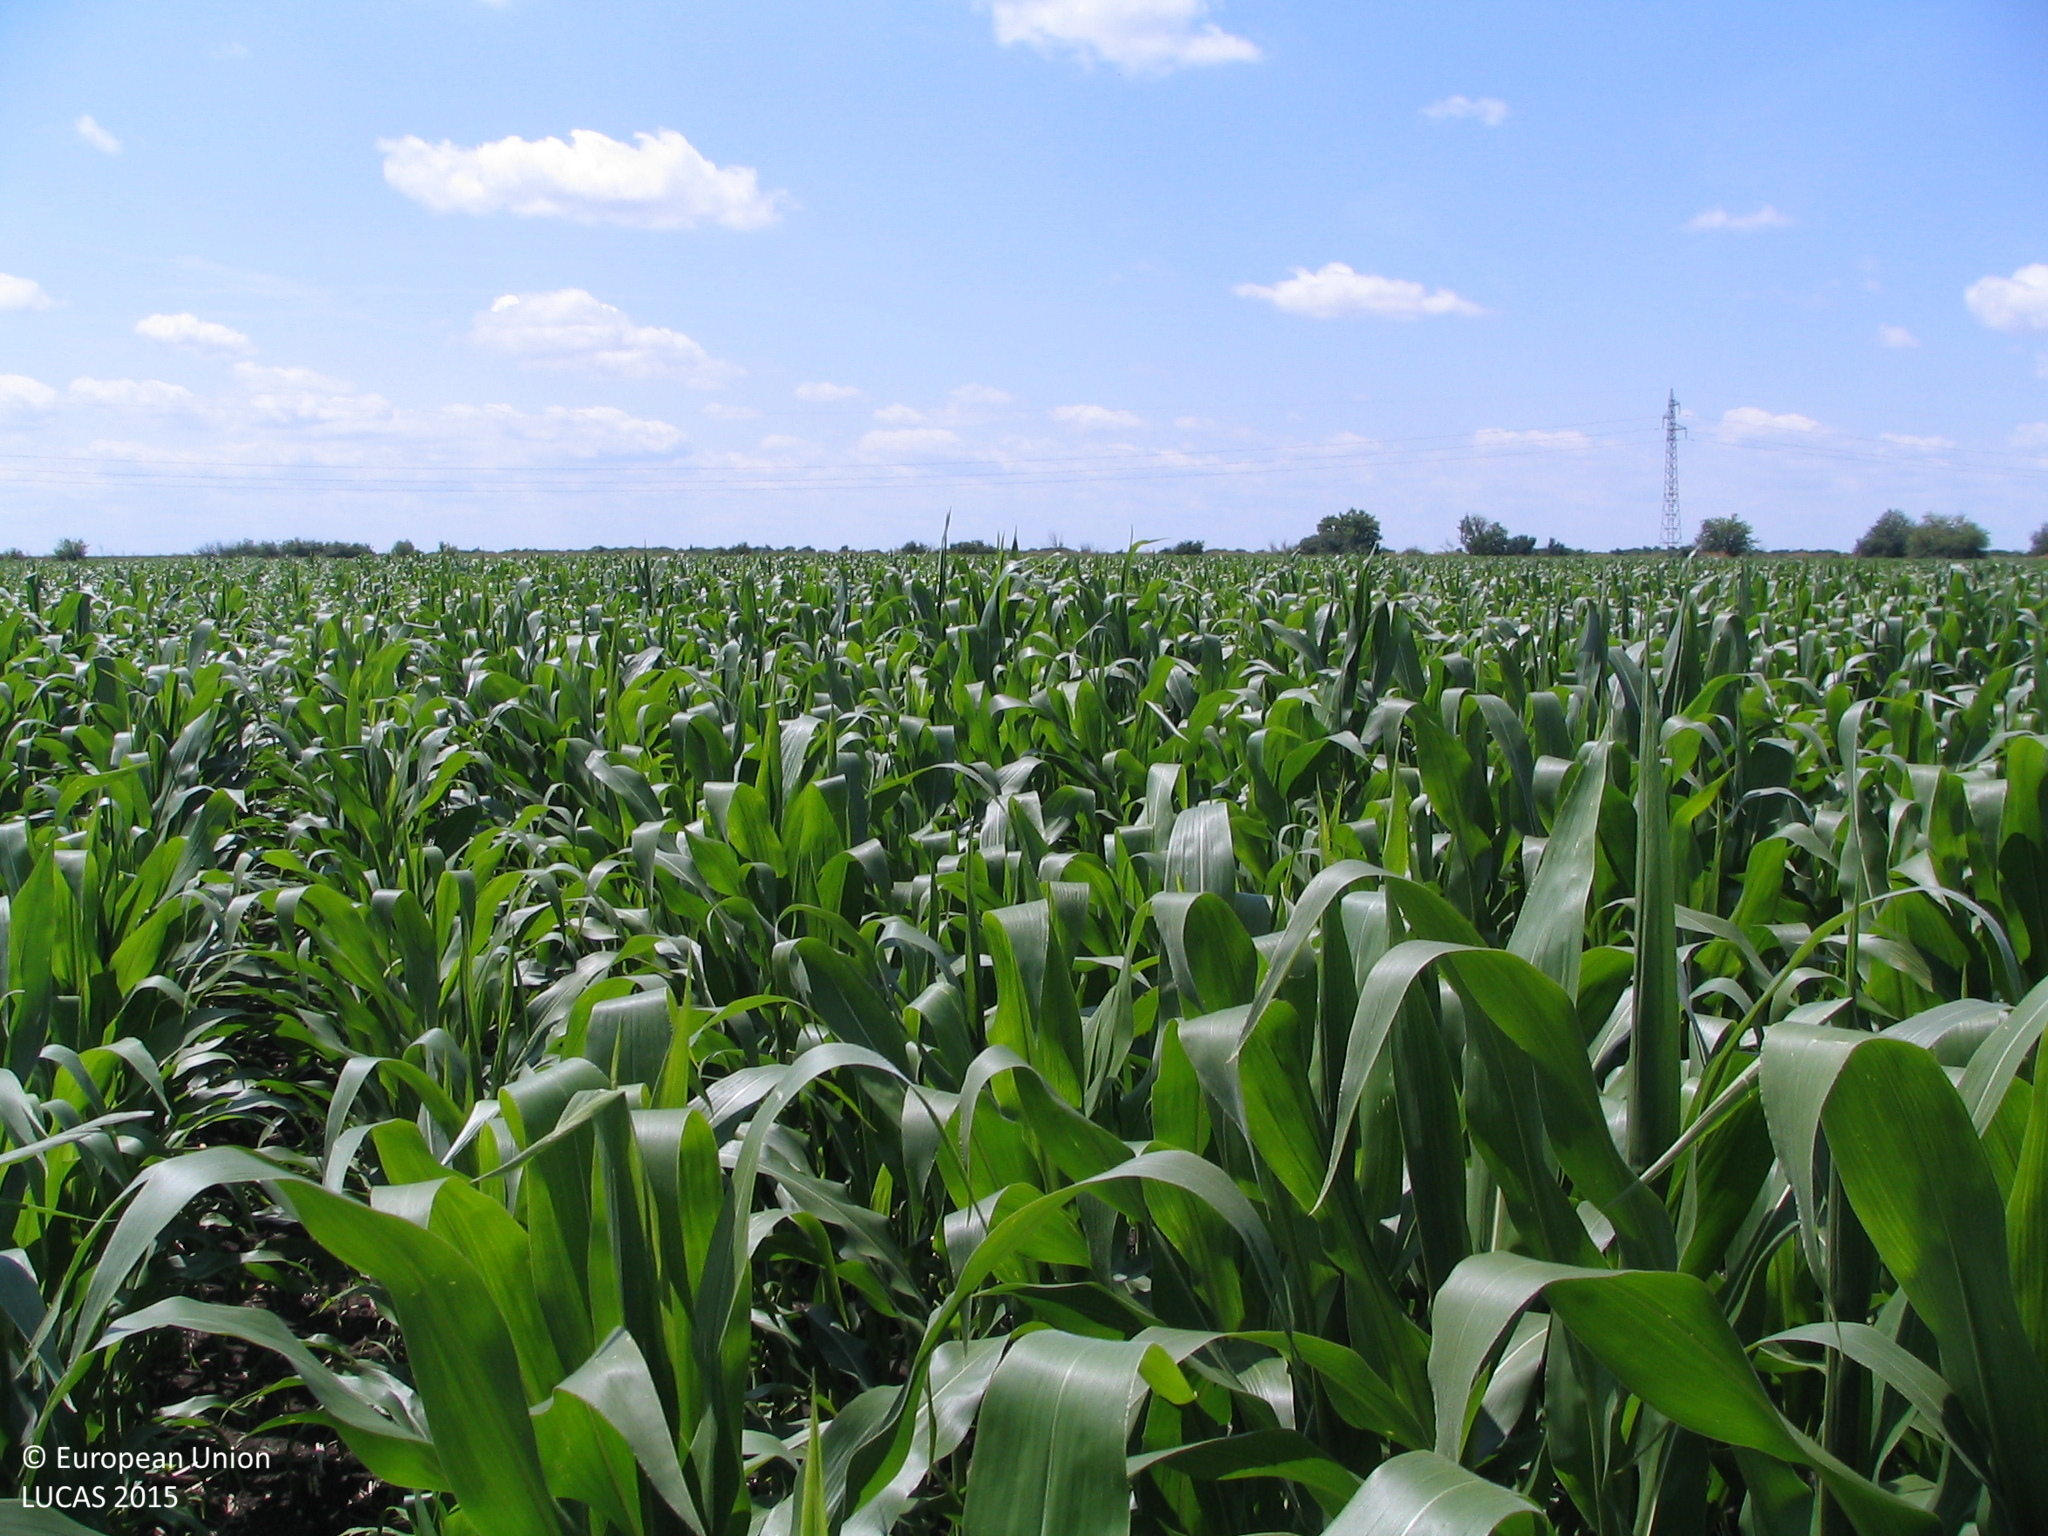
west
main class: Cropland
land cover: Maize
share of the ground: > 75 %
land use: Agriculture (excluding fallow land and kitchen gardens)
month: June
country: BG
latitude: 43.4403
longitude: 24.0768
